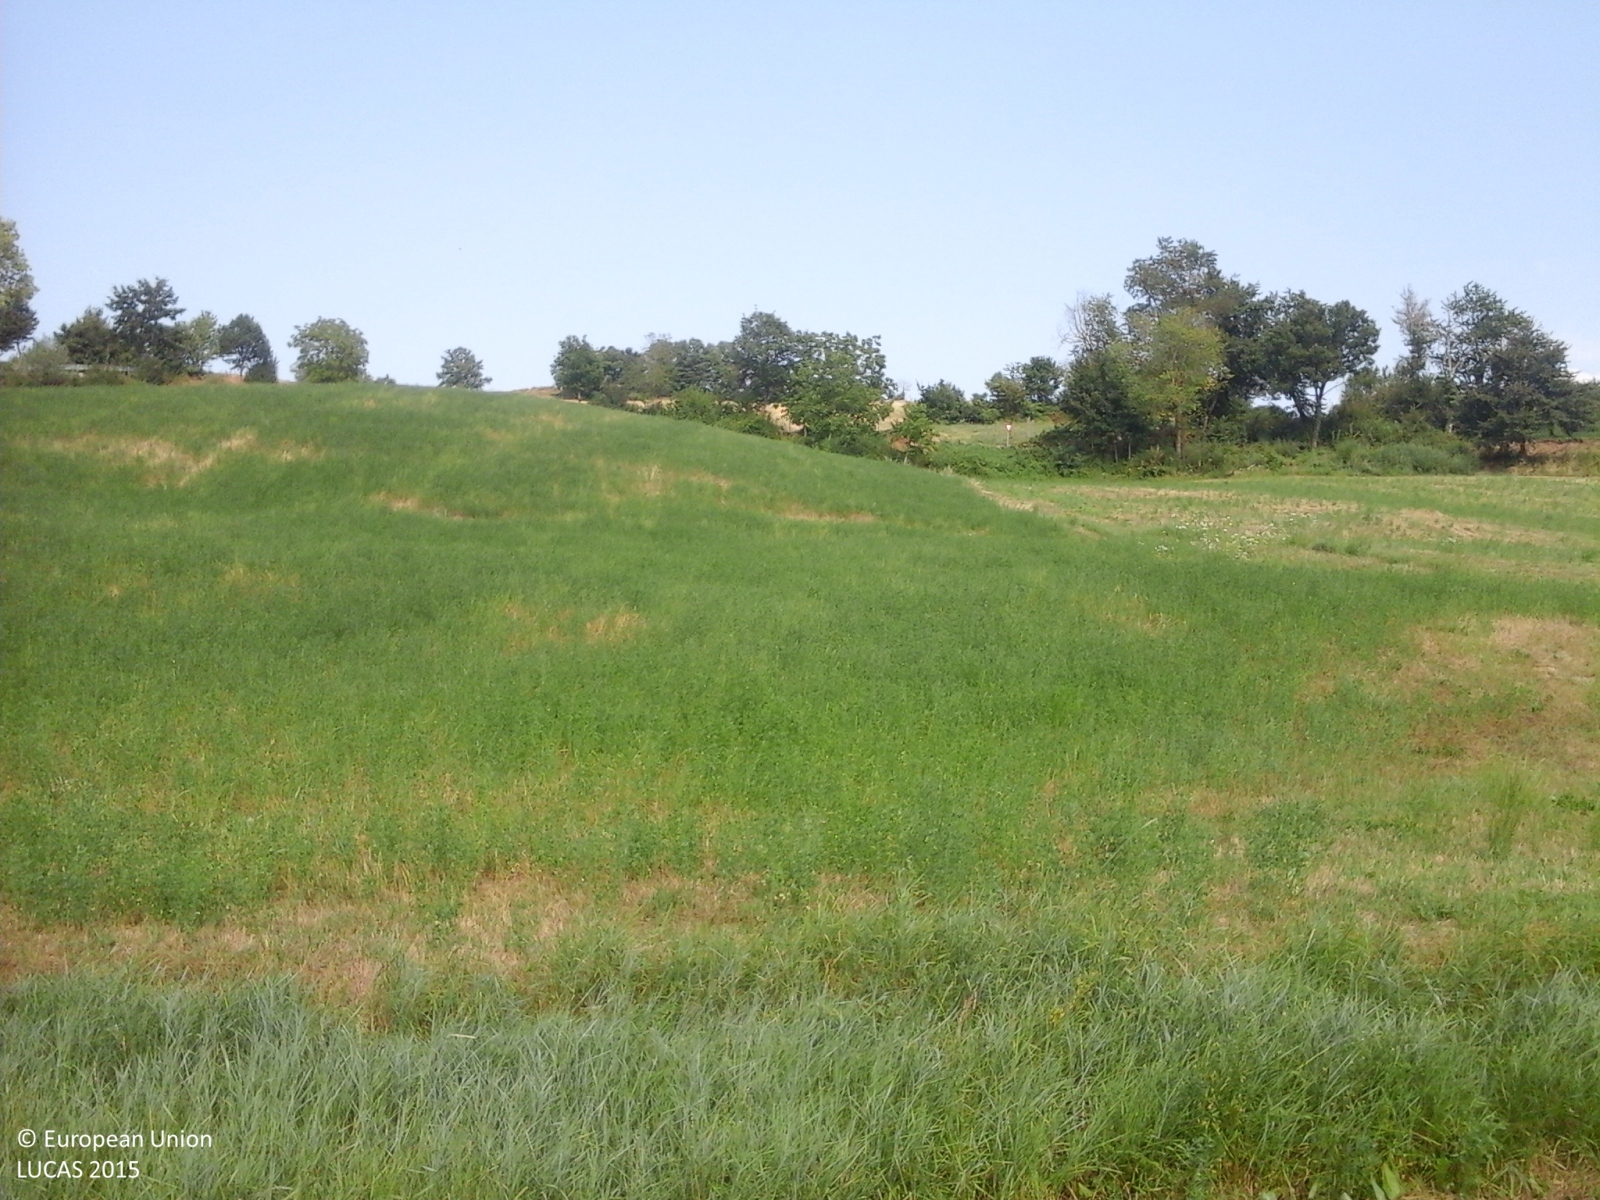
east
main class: Cropland
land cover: Lucerne
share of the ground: > 75 %
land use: Agriculture (excluding fallow land and kitchen gardens)
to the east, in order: Lucerne; Lines of trees; Grass margins; Paved roads, cycling and walking lanes; Grass margins; Ditches and canals; Lucerne
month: July
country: IT
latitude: 44.4210
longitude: 10.5890
